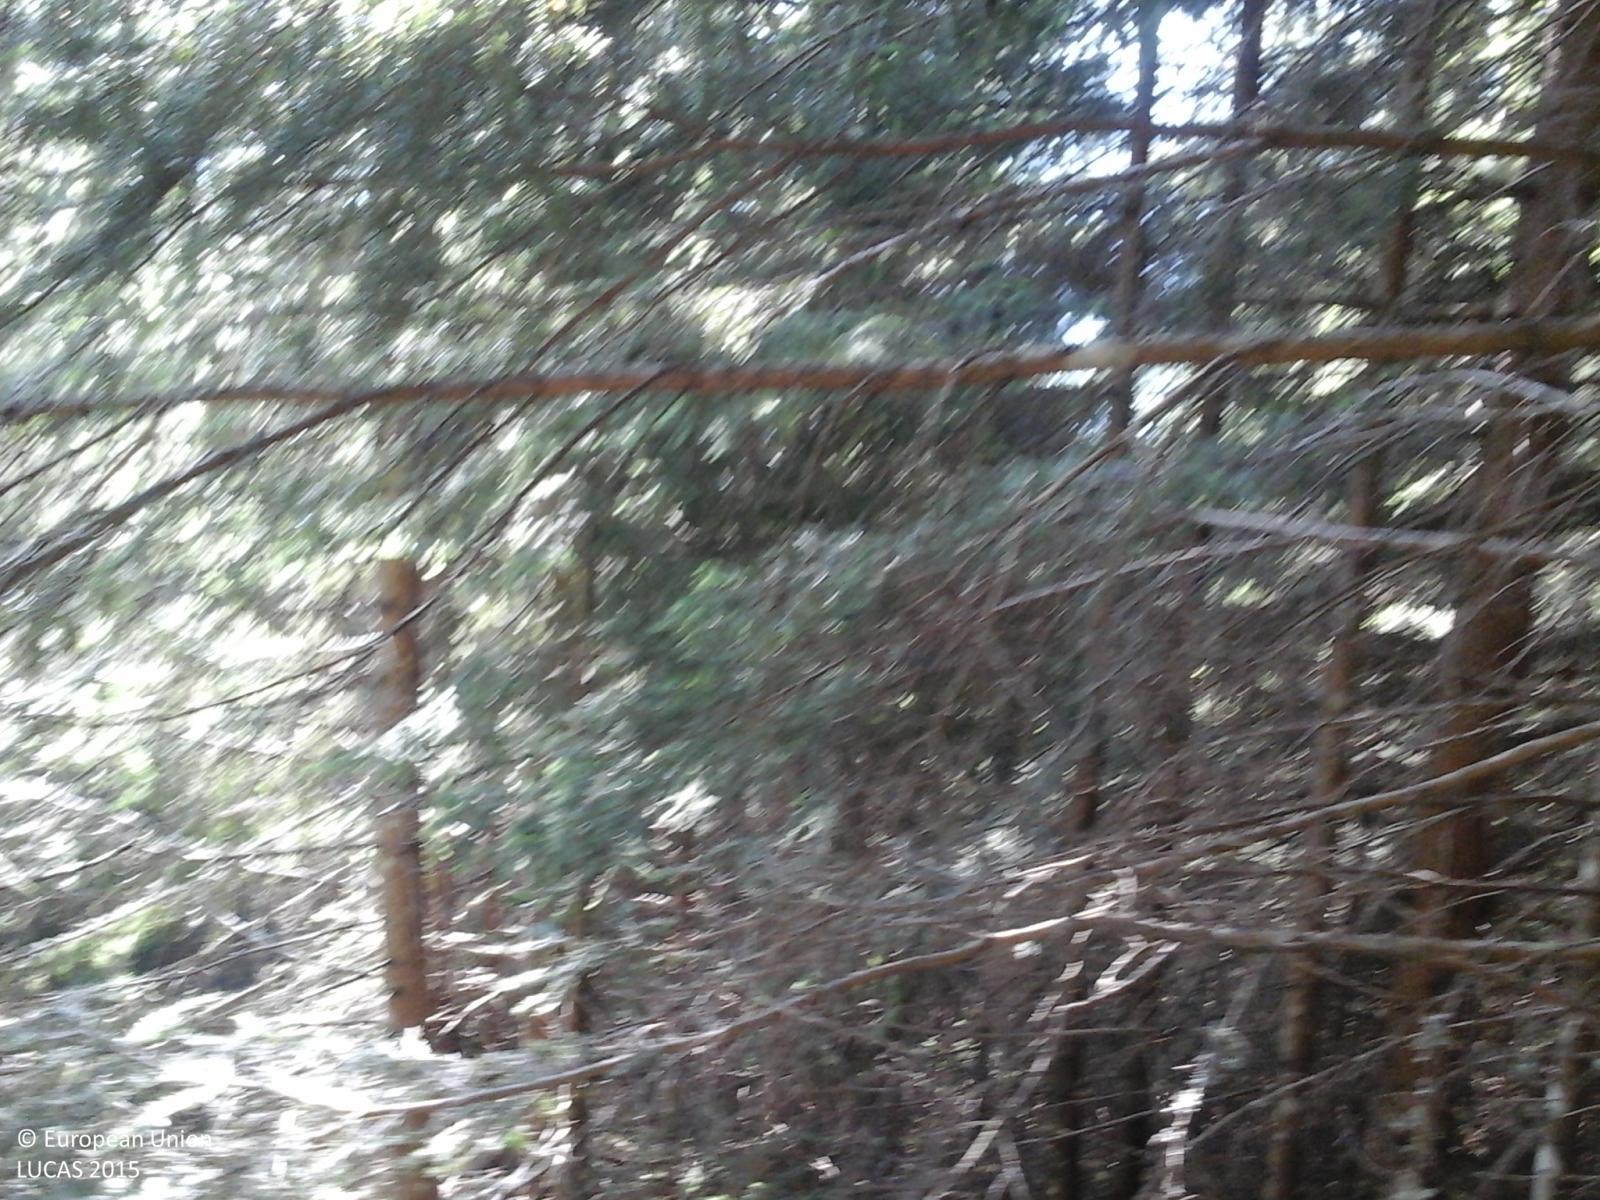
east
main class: Woodland
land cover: Spruce dominated coniferous woodland
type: alpine coniferous forest
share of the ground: > 75 %
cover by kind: coniferous forest trees 100 %
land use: Forestry
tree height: > 5 m
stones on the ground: 25 - 50 %
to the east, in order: Spruce dominated coniferous woodland; Grassland without tree/shrub cover; Spruce dominated coniferous woodland
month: June
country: IT
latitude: 46.6994
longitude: 11.6068
